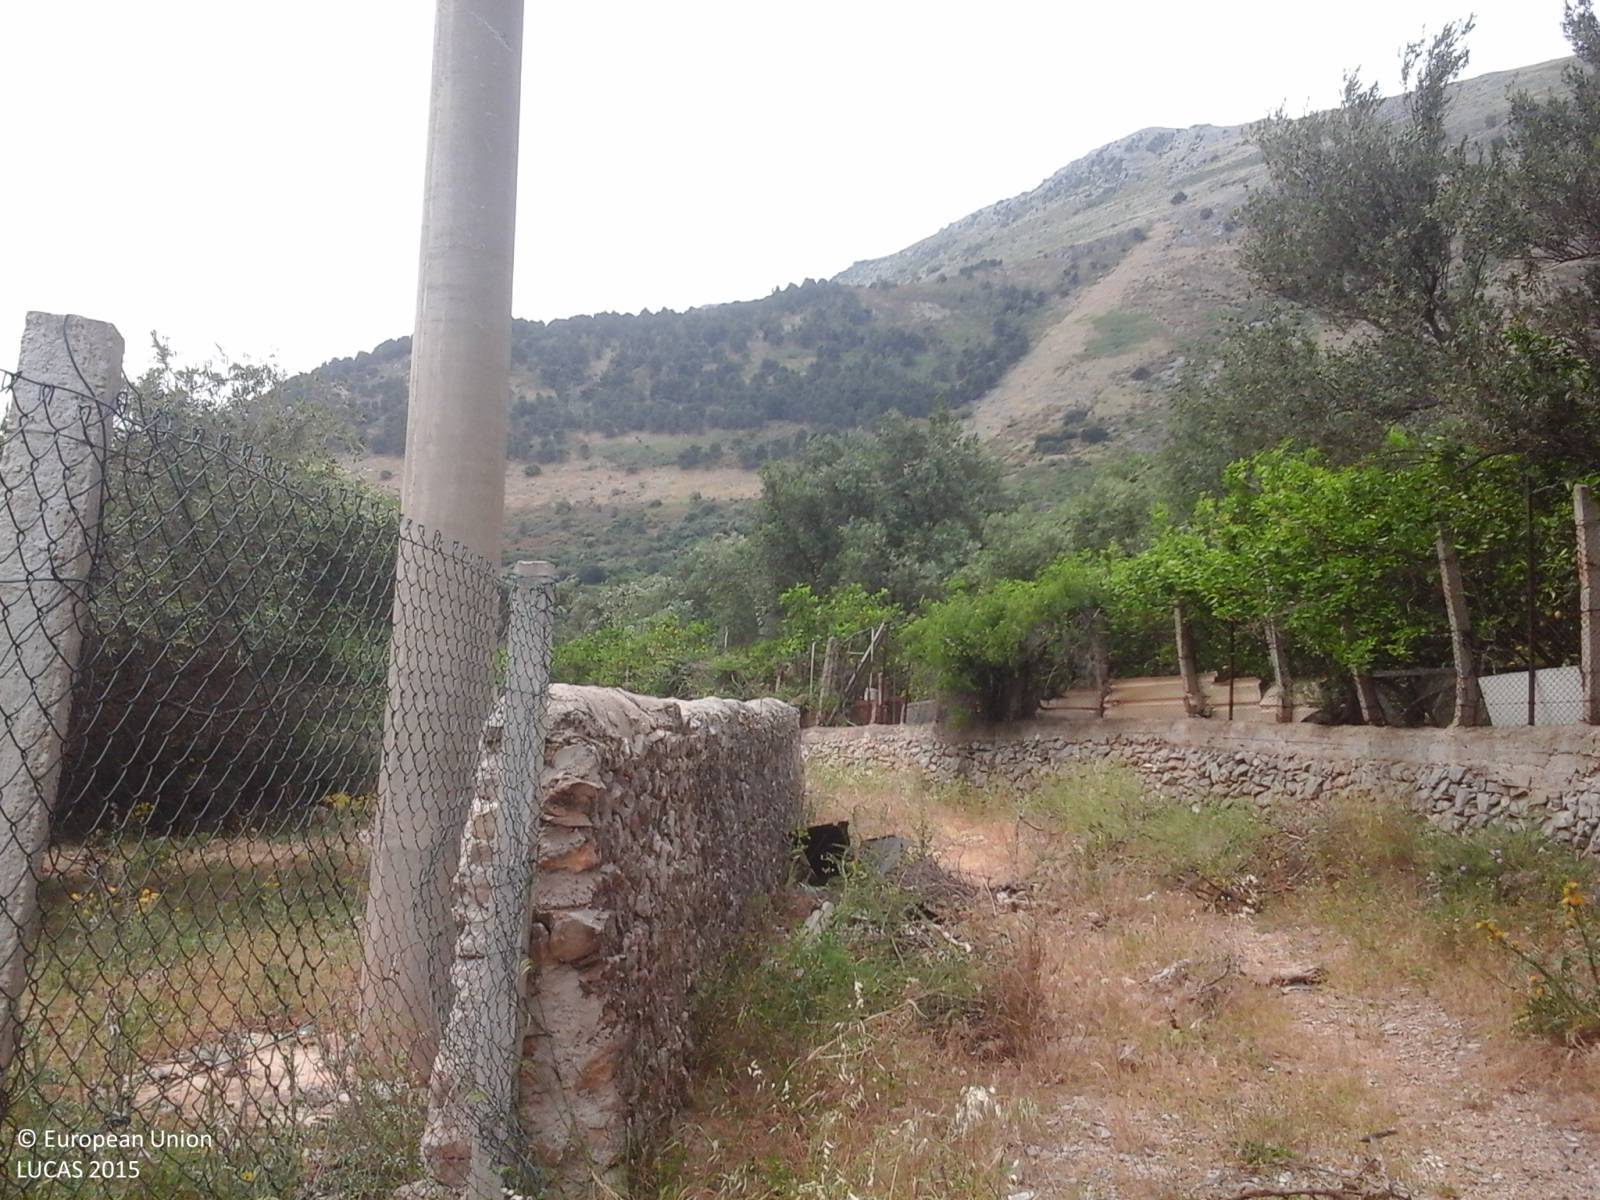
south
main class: Cropland
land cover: Olive groves
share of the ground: 25 - 50 %
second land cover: Spontaneously vegetated surfaces
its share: > 75 %
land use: Agriculture (excluding fallow land and kitchen gardens)
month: May
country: IT
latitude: 38.1490
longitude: 13.1616
